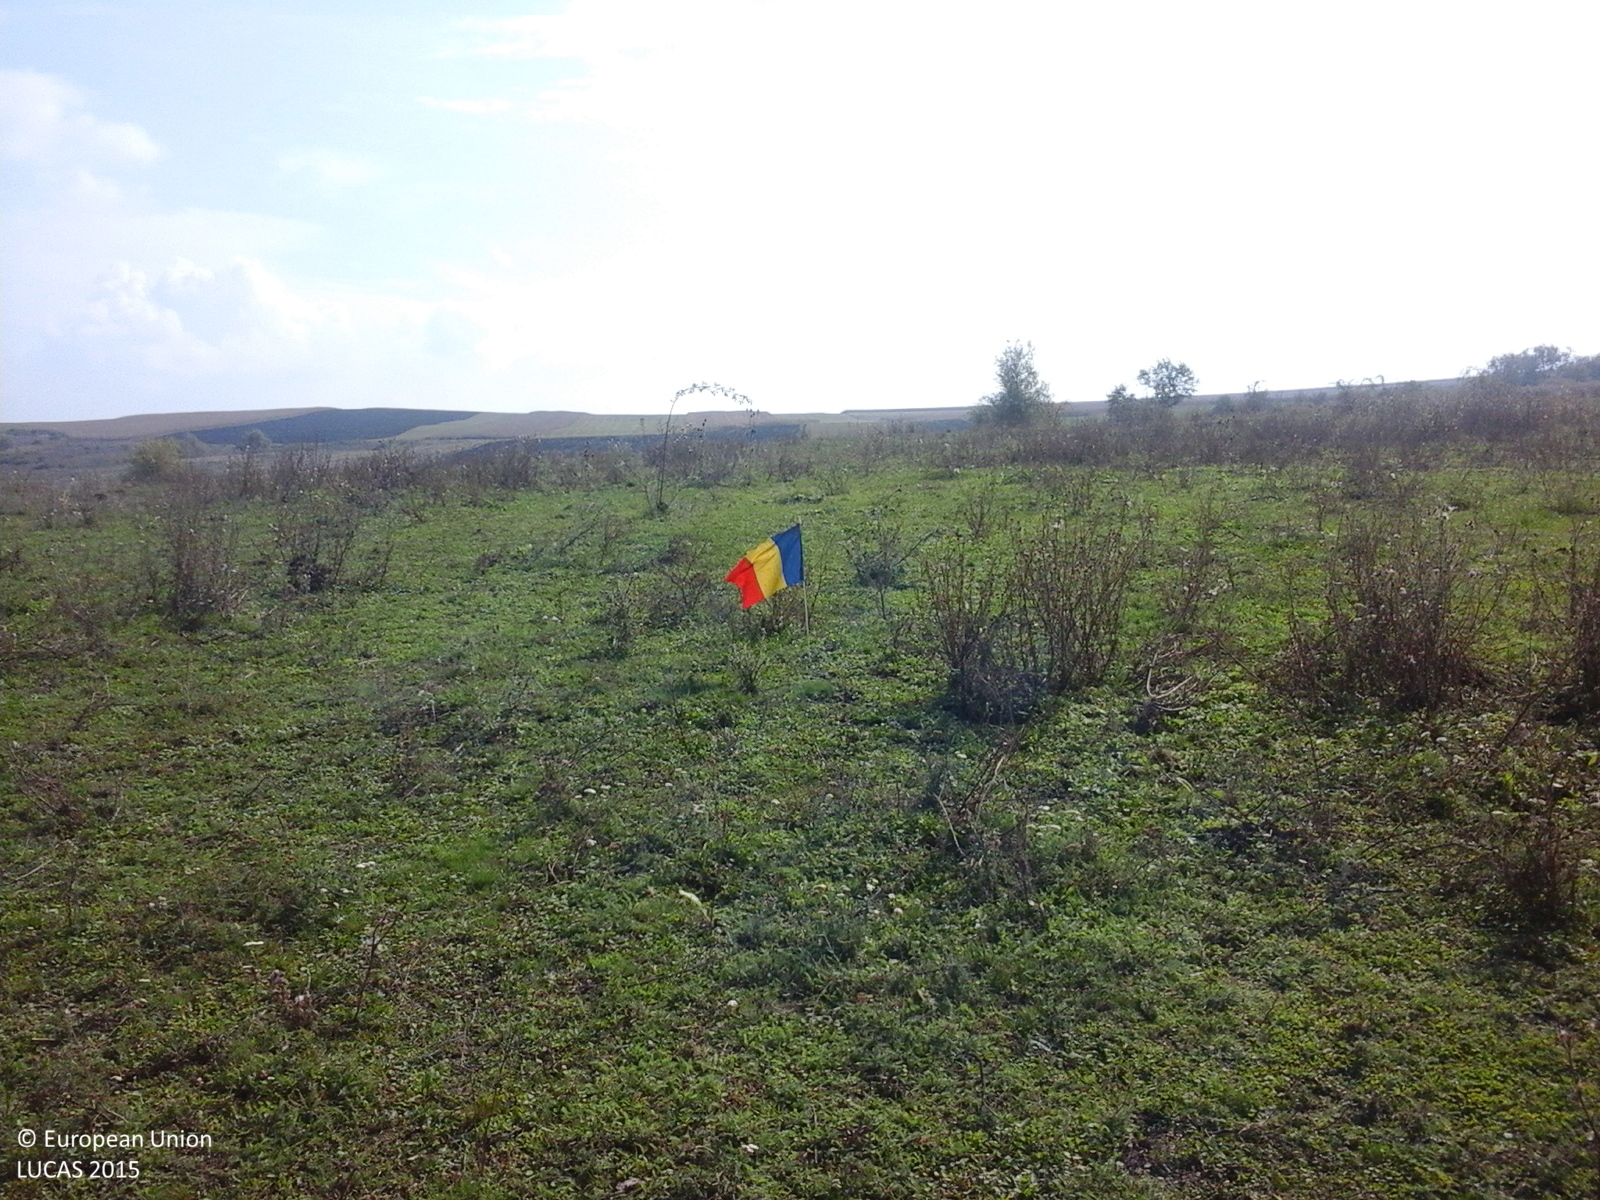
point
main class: Grassland
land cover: Spontaneously vegetated surfaces
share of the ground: > 75 %
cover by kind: herbaceous plants 100 %
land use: Agriculture (excluding fallow land and kitchen gardens)
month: October
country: RO
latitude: 46.4657
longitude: 23.8645
